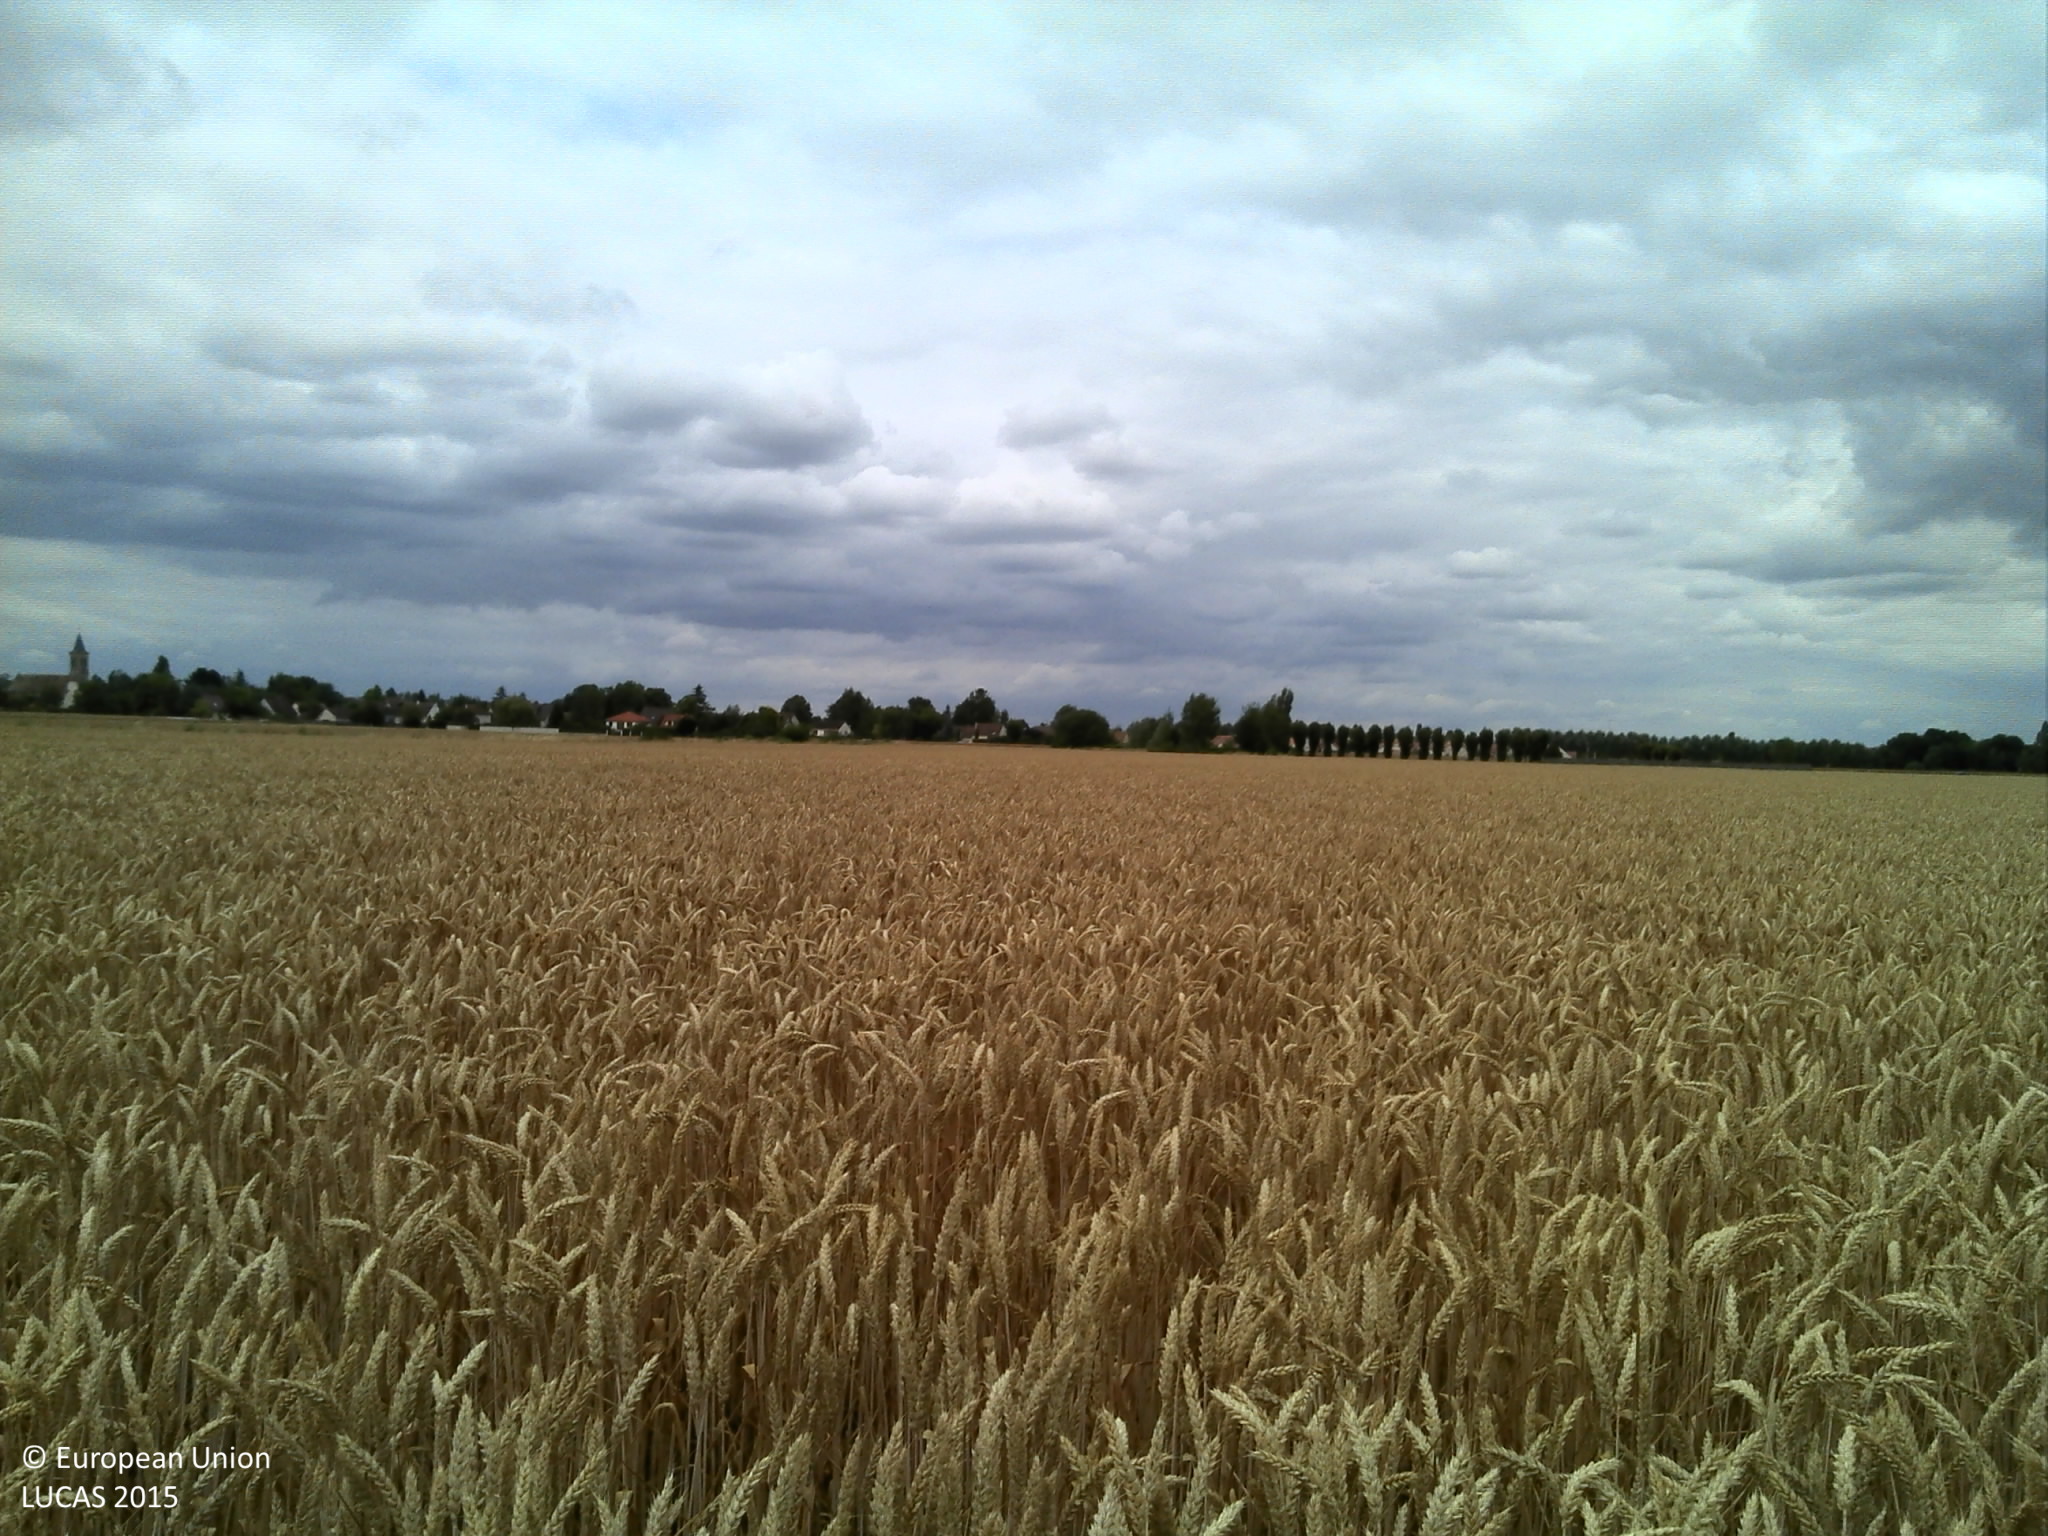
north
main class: Cropland
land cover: Common wheat
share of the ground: > 75 %
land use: Agriculture (excluding fallow land and kitchen gardens)
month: July
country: FR
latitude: 48.5245
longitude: 2.4471
